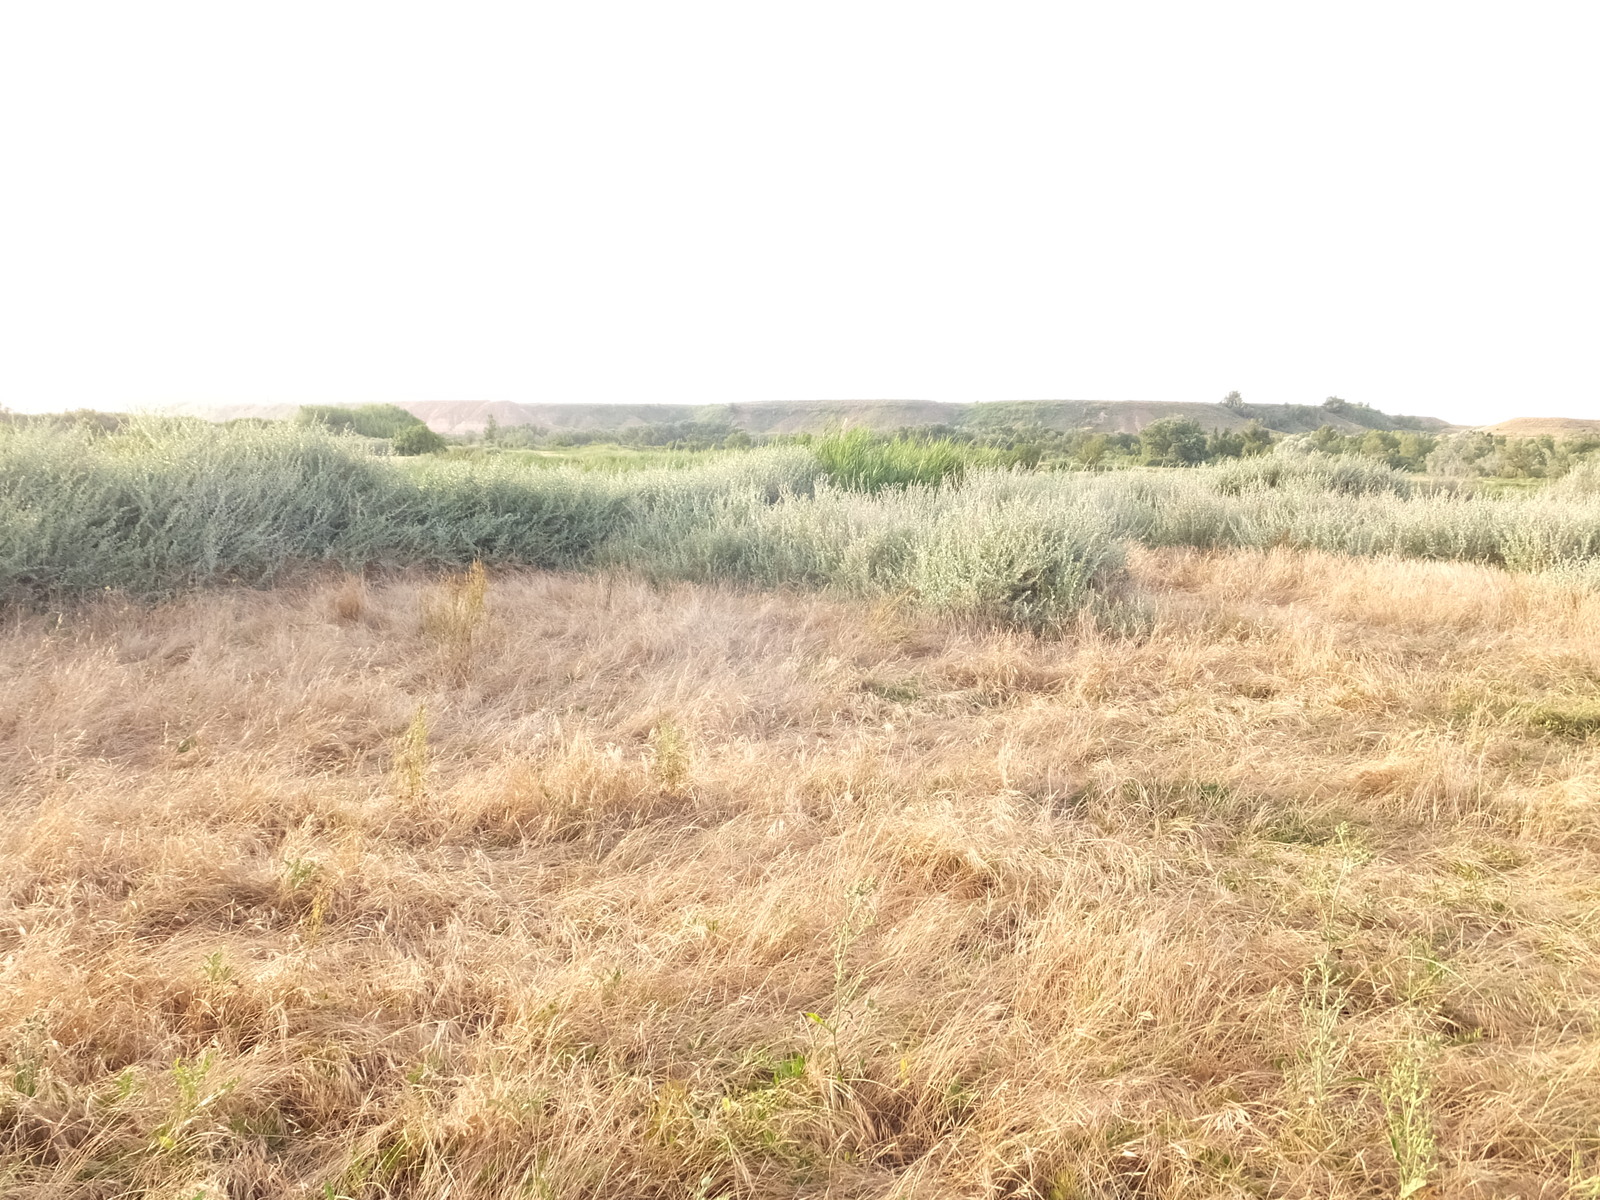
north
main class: Grassland
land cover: Grassland with sparse tree/shrub cover
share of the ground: > 75 %
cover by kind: herbaceous plants 85 %, shrubs 10 %, broadleaved forest trees 5 %
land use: Semi-natural and natural areas not in use
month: June
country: ES
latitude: 41.6899
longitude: 0.0480
